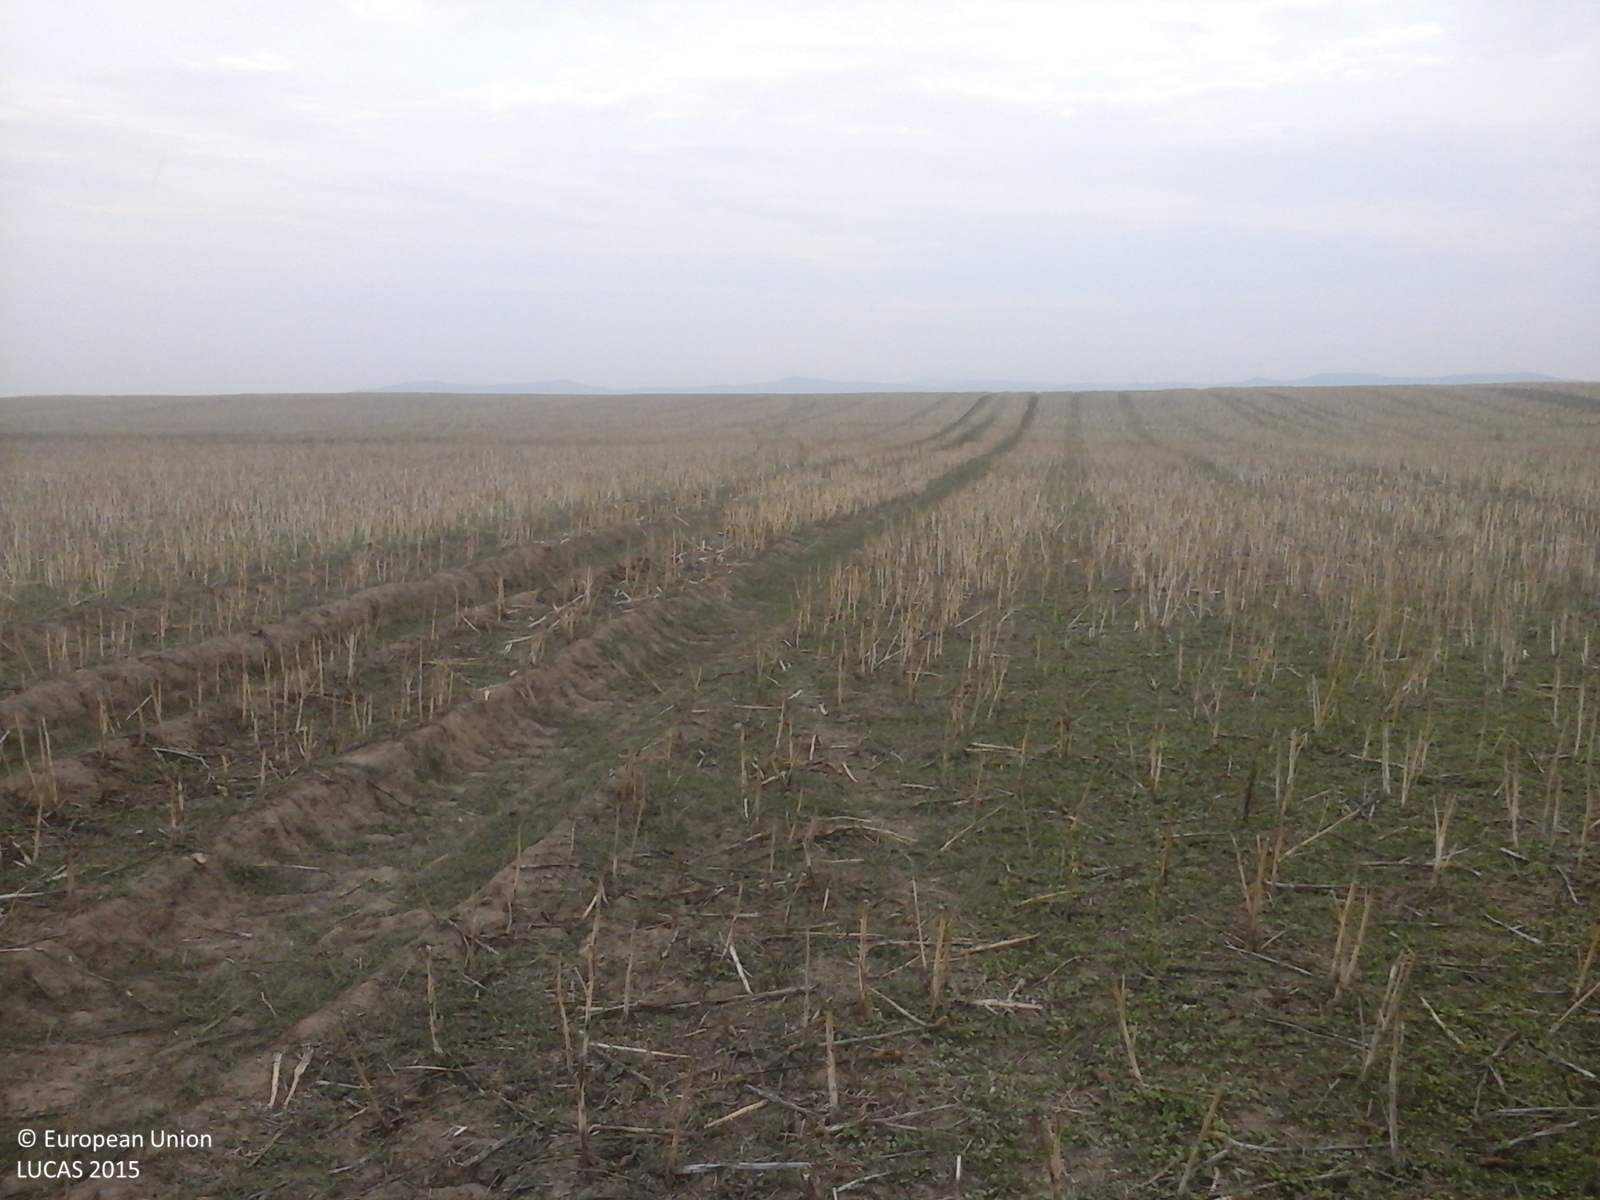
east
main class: Cropland
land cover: Rape and turnip rape
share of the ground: 10 - 25 %
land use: Agriculture (excluding fallow land and kitchen gardens)
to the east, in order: Rape and turnip rape
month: August
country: RO
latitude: 46.2270
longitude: 21.4322
